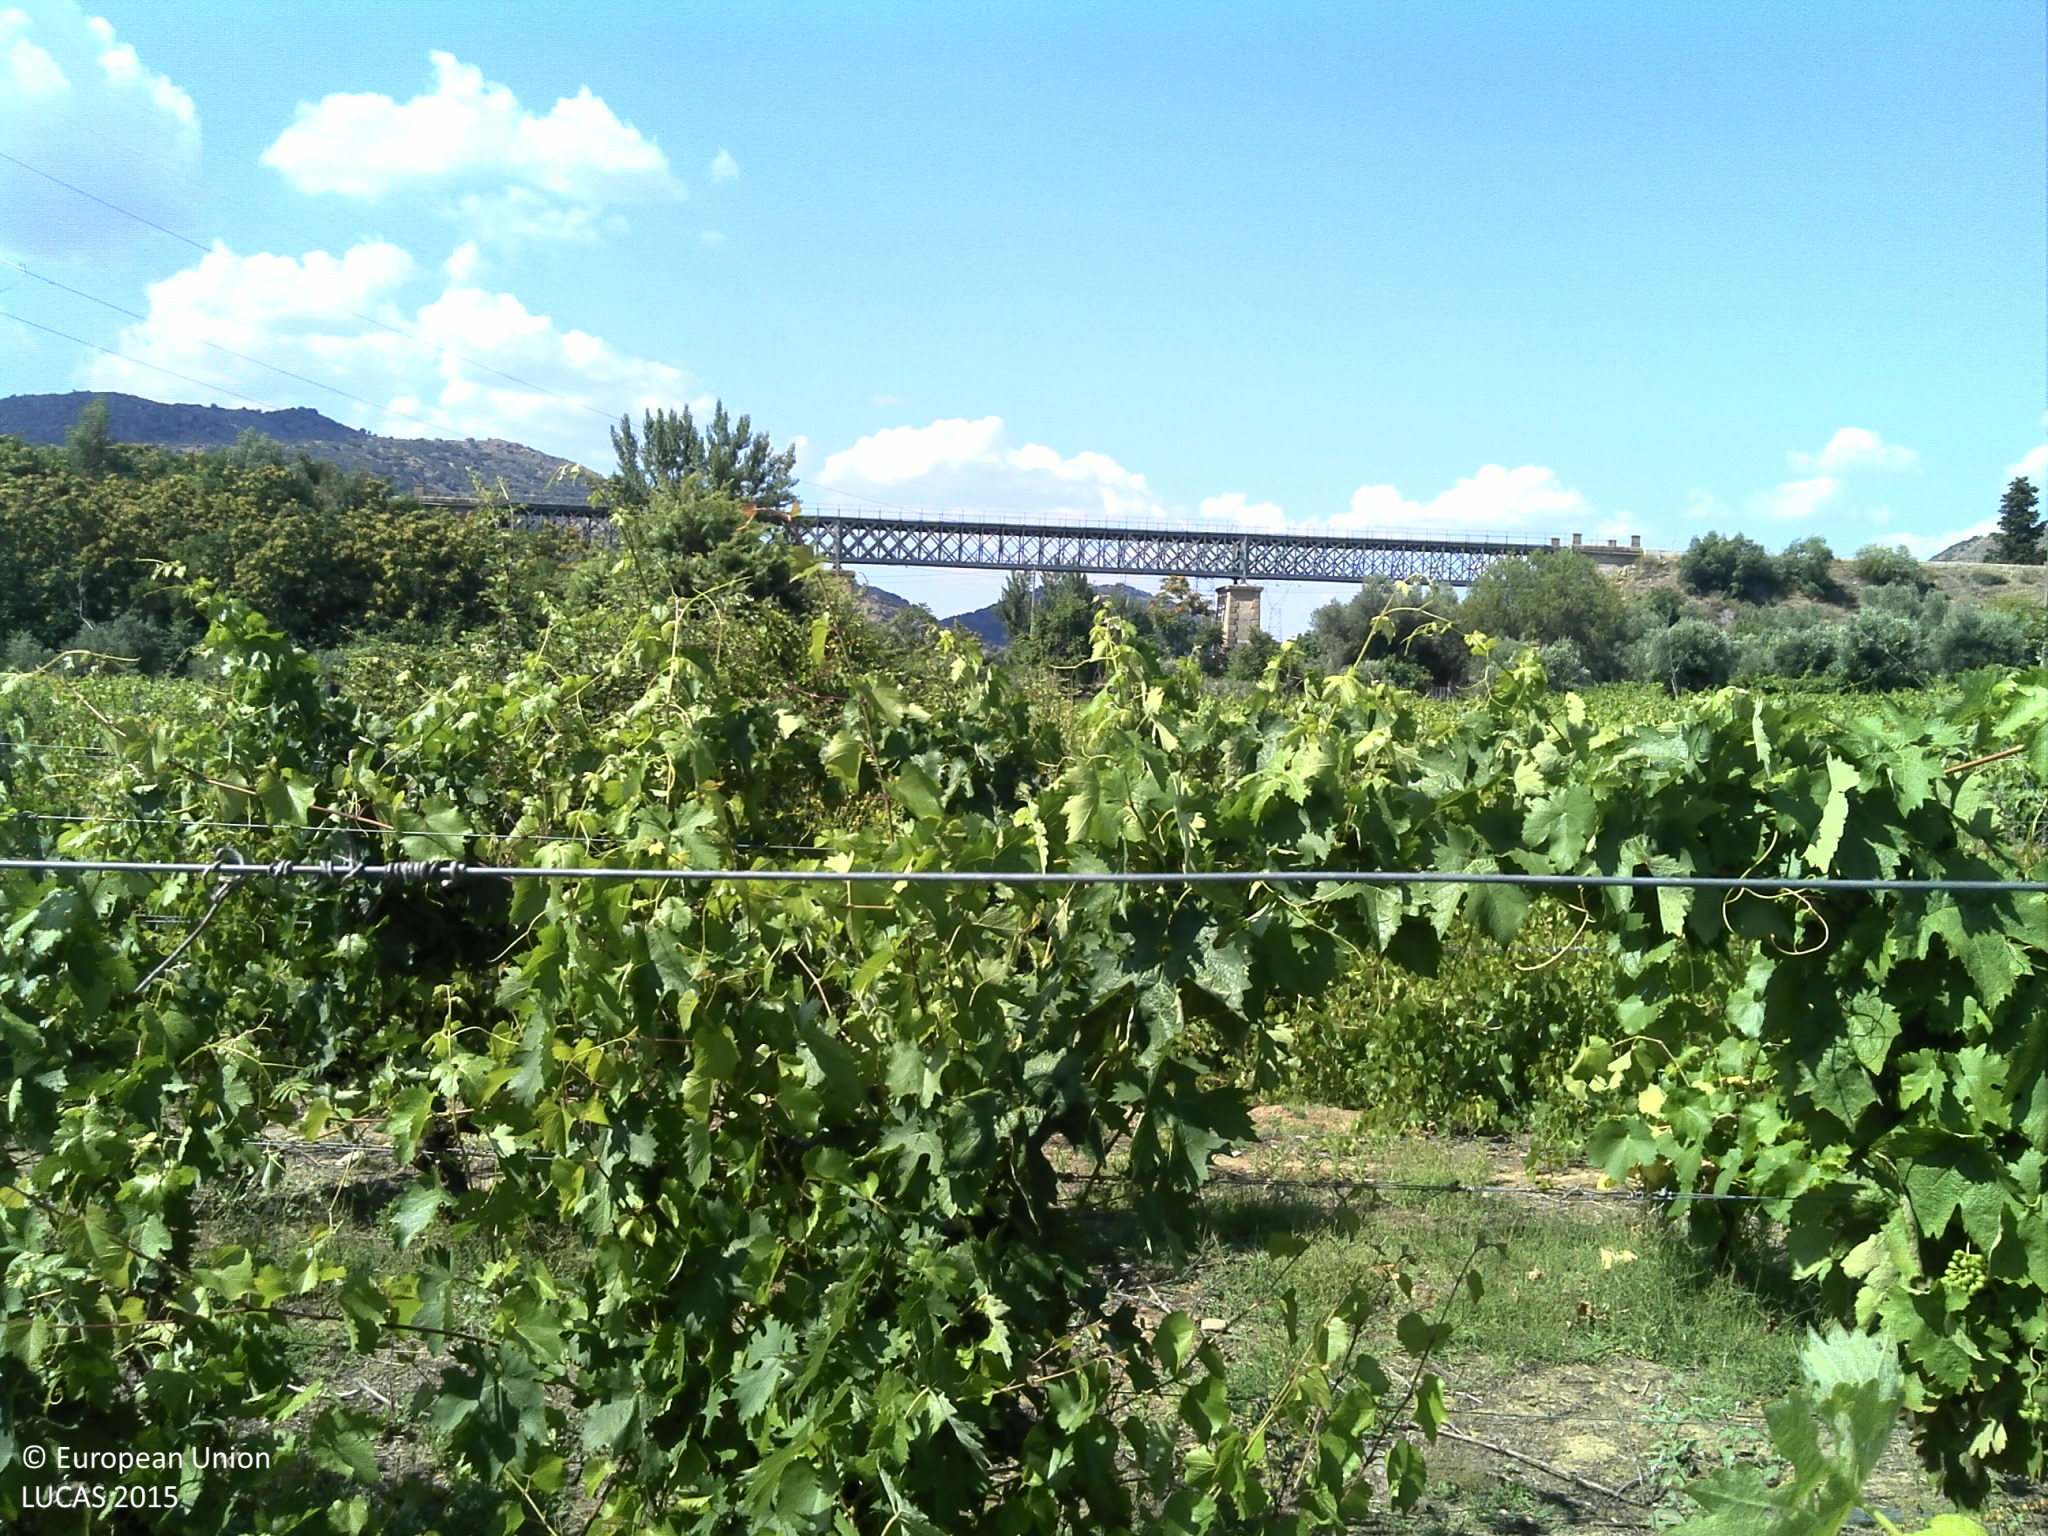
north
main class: Cropland
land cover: Vineyards
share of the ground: 25 - 50 %
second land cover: Grassland without tree/shrub cover
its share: 25 - 50 %
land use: Agriculture (excluding fallow land and kitchen gardens)
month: June
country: PT
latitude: 41.1260
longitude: -7.1332
